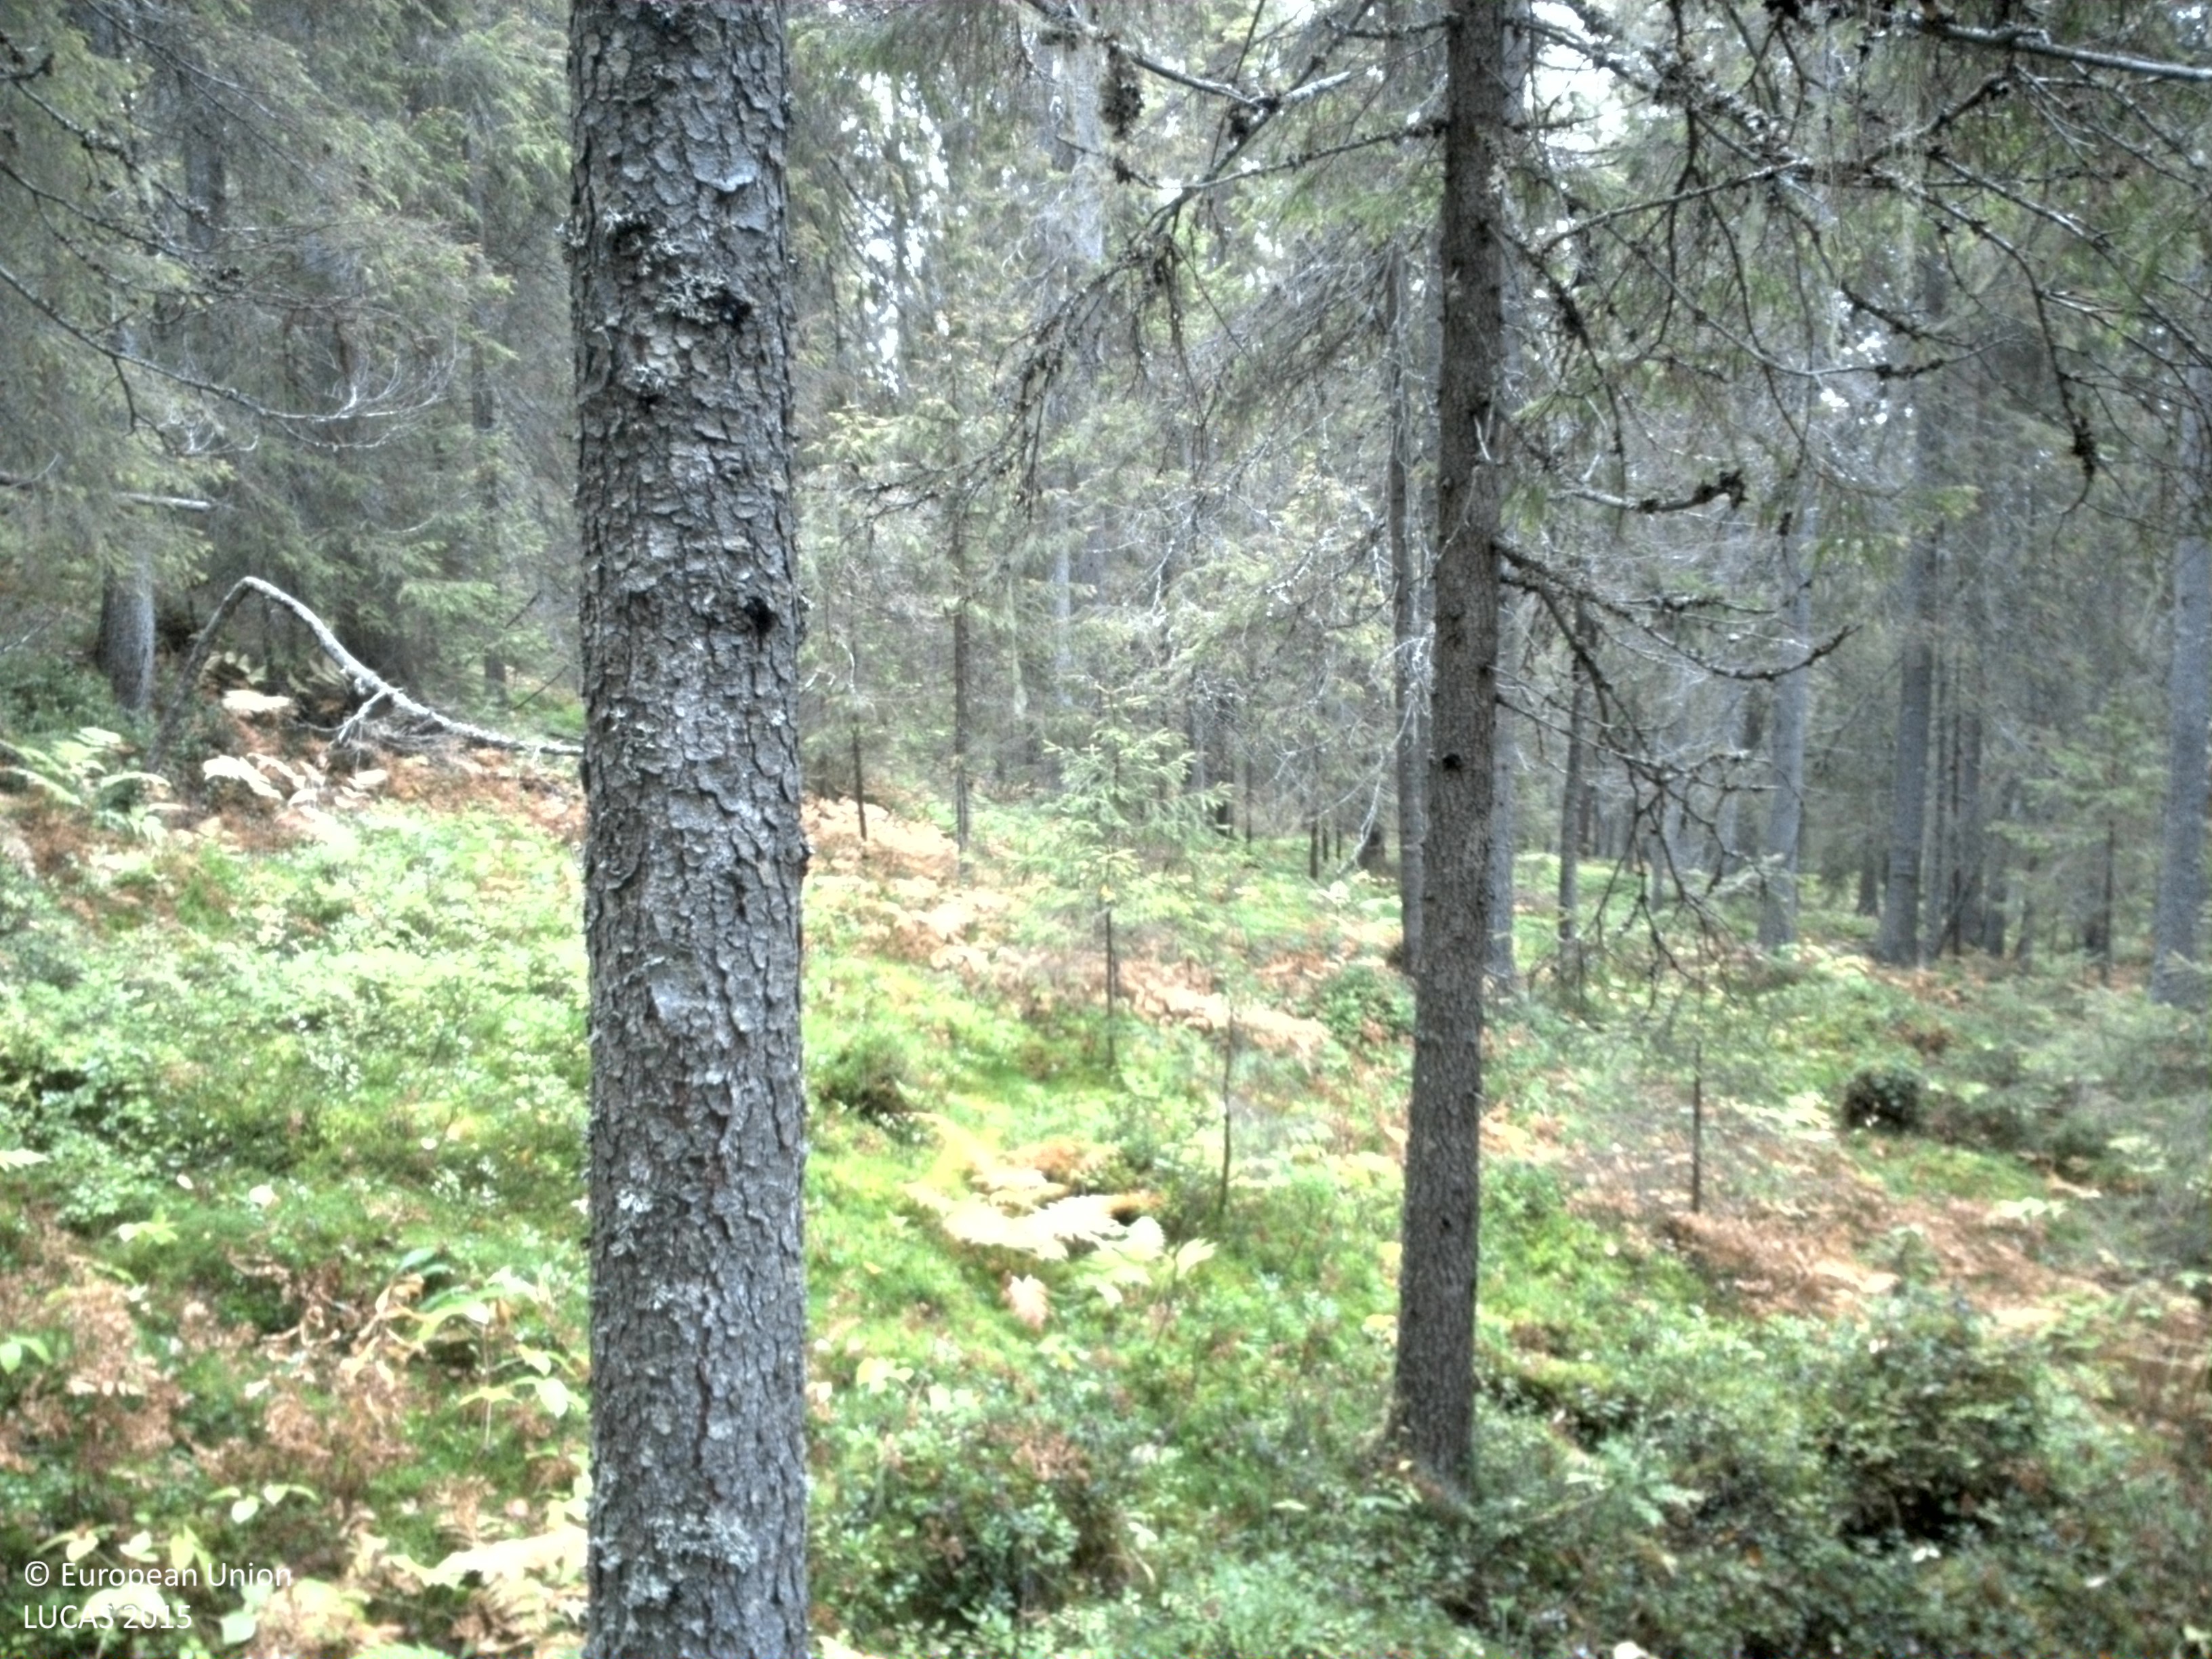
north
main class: Woodland
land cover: Spruce dominated coniferous woodland
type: boreal forest
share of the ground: 50 - 75 %
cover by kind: coniferous forest trees 60 %, shrubs 15 %, herbaceous plants 15 %, lichens and mosses 10 %
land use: Forestry
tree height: > 5 m
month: September
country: SE
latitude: 64.8784
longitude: 17.7966
